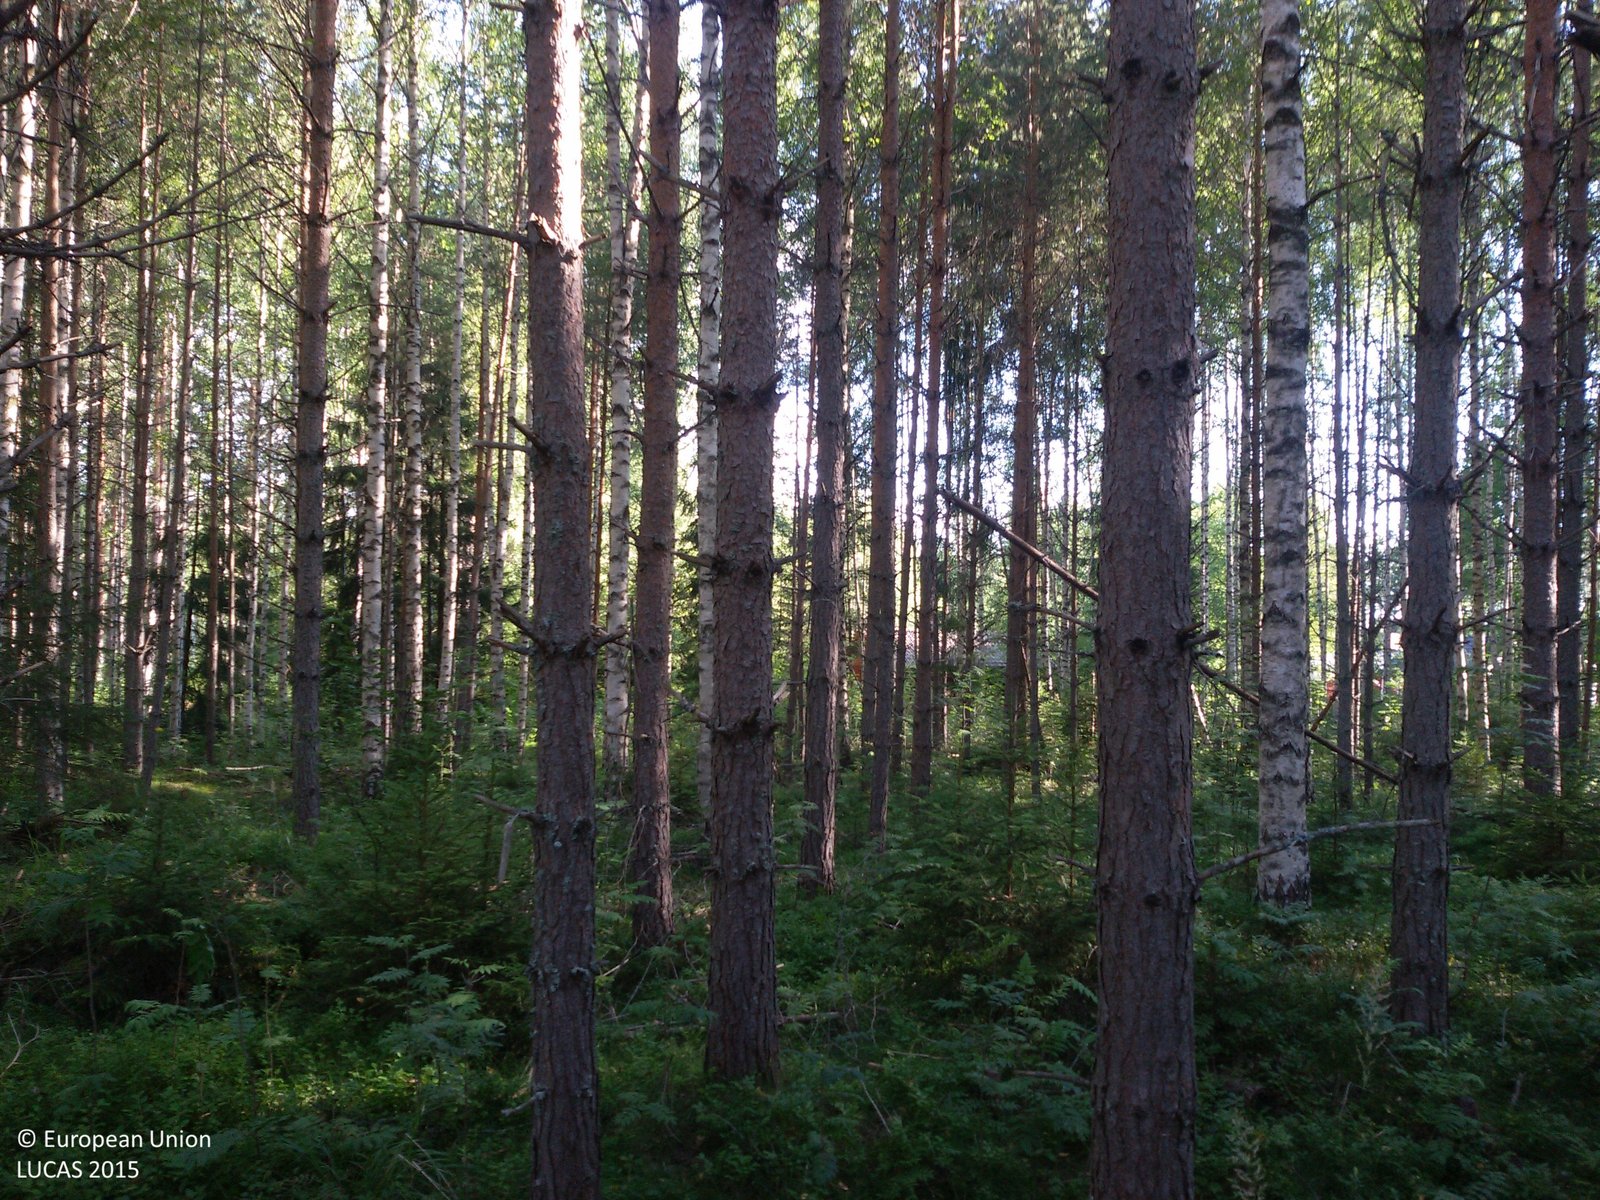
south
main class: Woodland
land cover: Pine dominated mixed woodland
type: boreal forest
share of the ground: > 75 %
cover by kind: coniferous forest trees 50 %, broadleaved forest trees 45 %, shrubs 5 %
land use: Forestry
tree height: > 5 m
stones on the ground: < 10 %
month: August
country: SE
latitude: 60.5762
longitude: 16.4298
